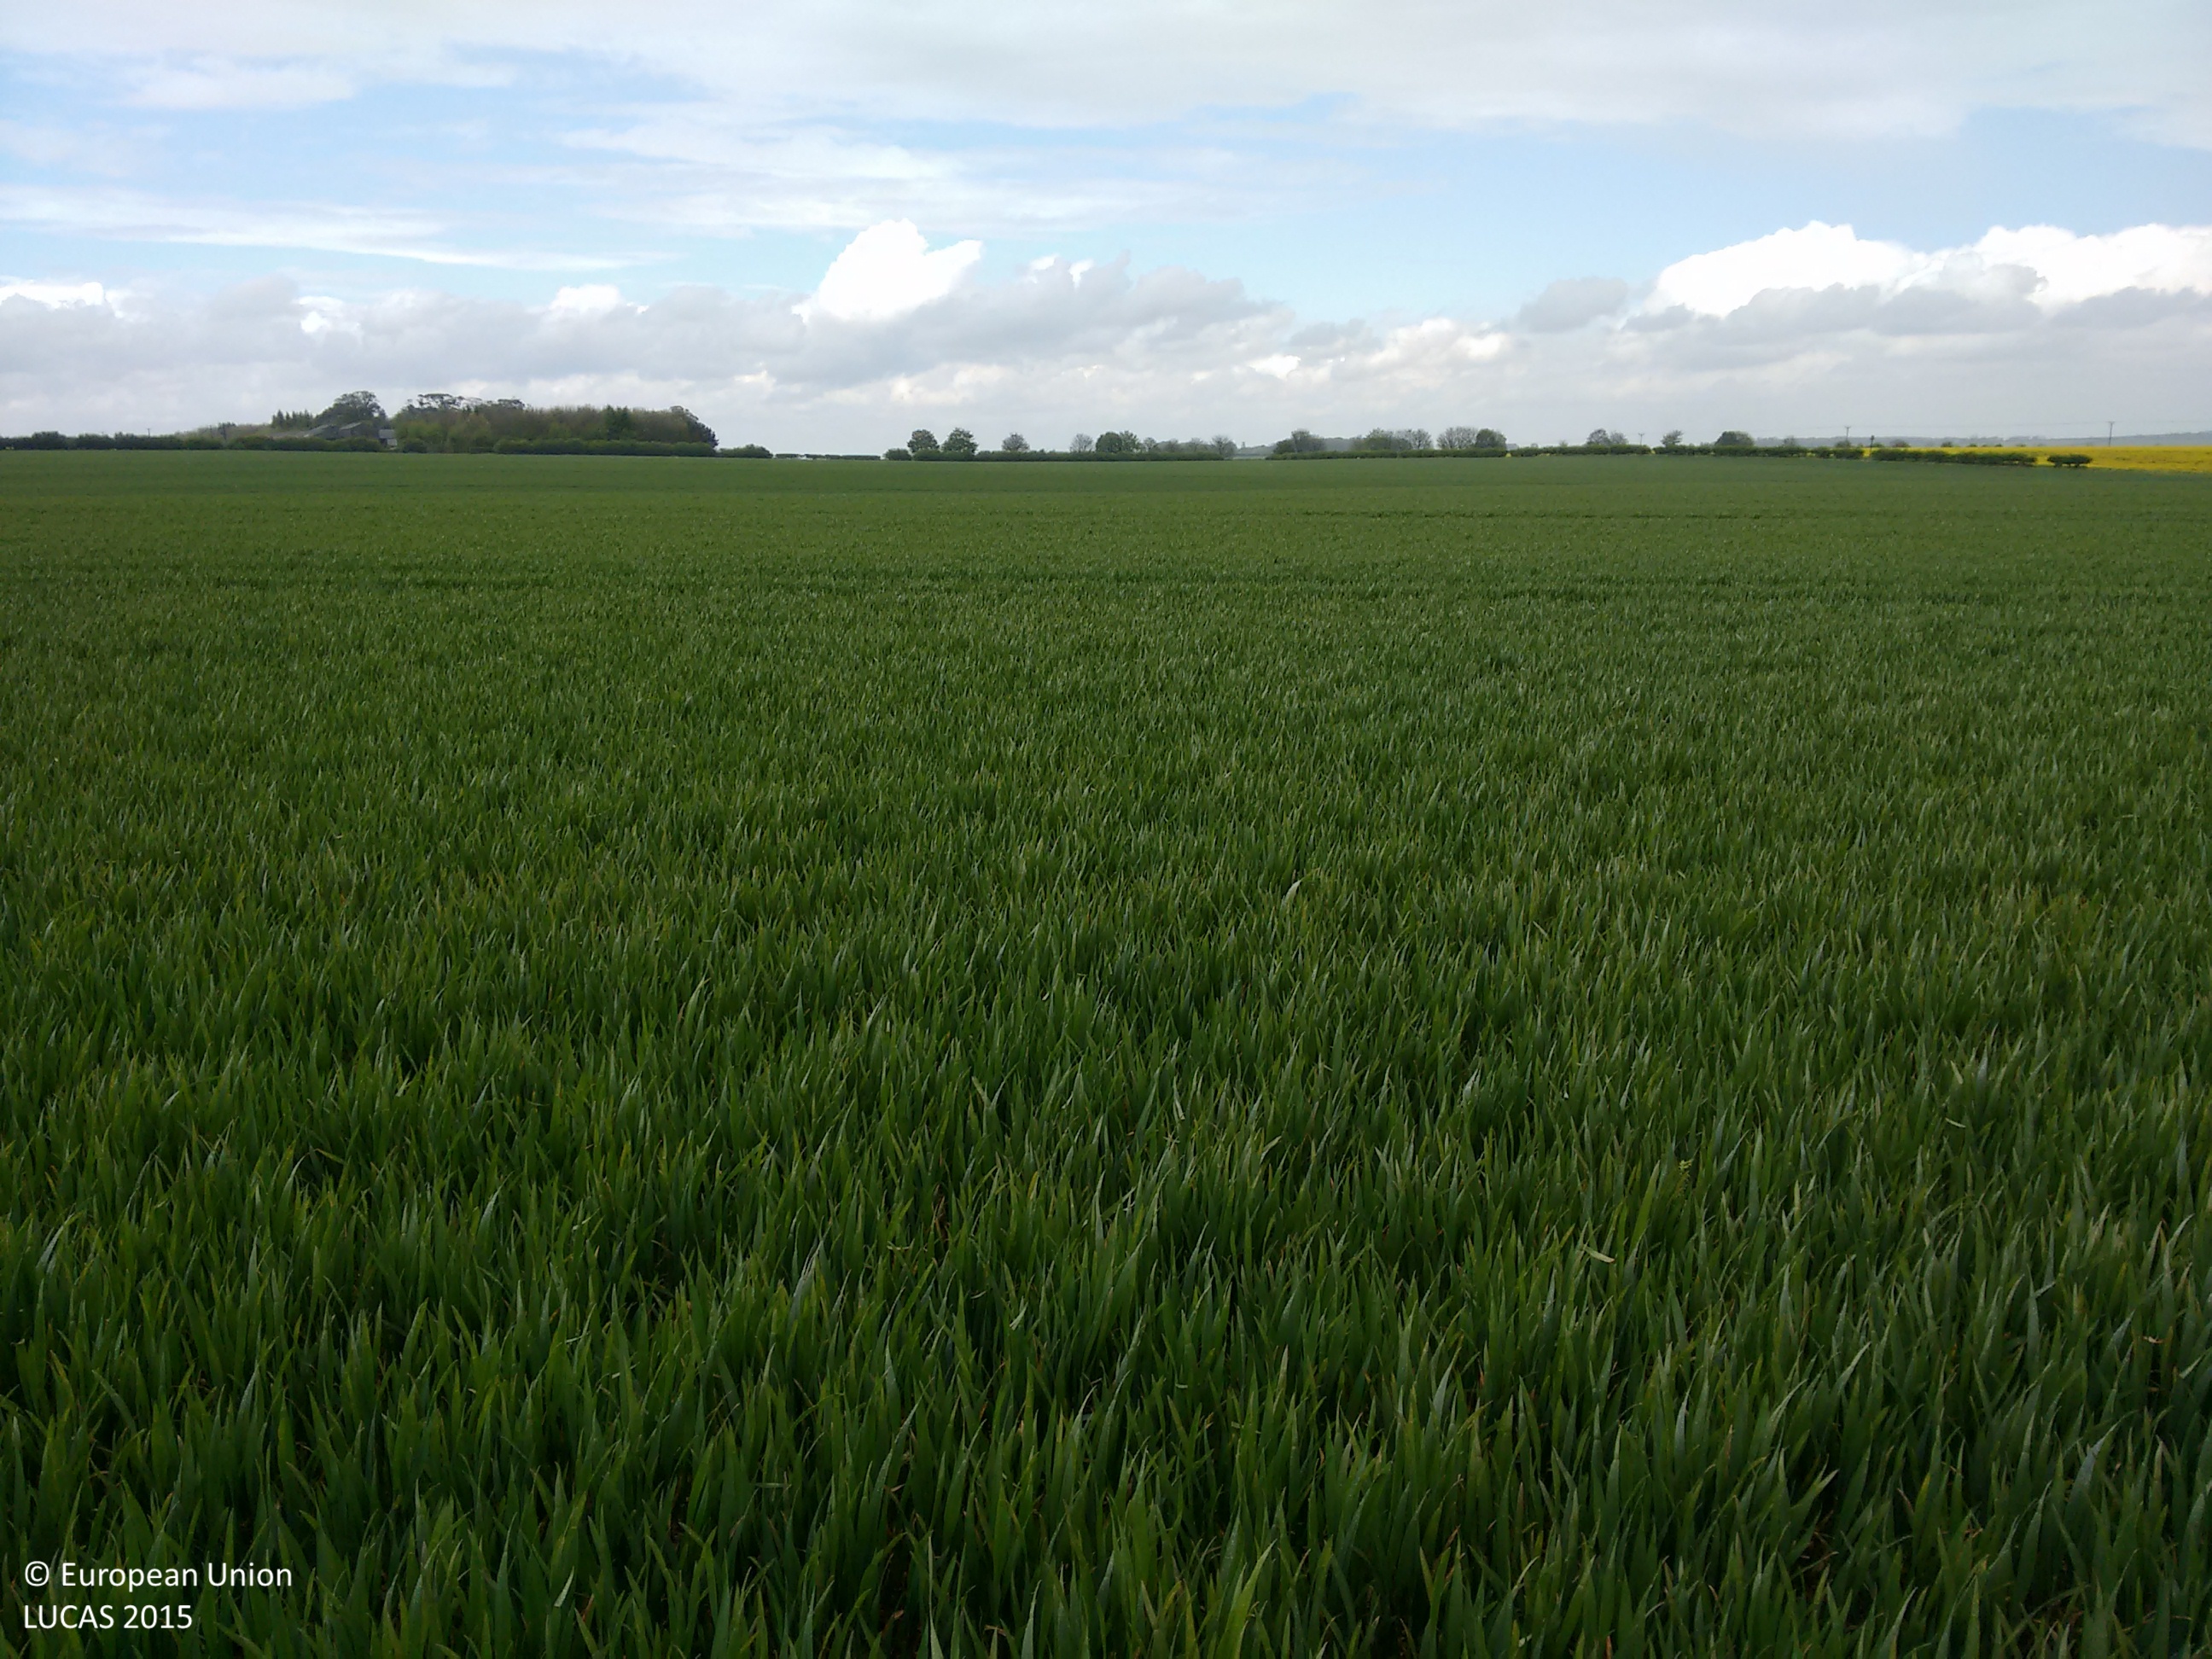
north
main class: Cropland
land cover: Barley
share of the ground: > 75 %
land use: Agriculture (excluding fallow land and kitchen gardens)
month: May
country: GB
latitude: 53.3910
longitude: -0.1533
